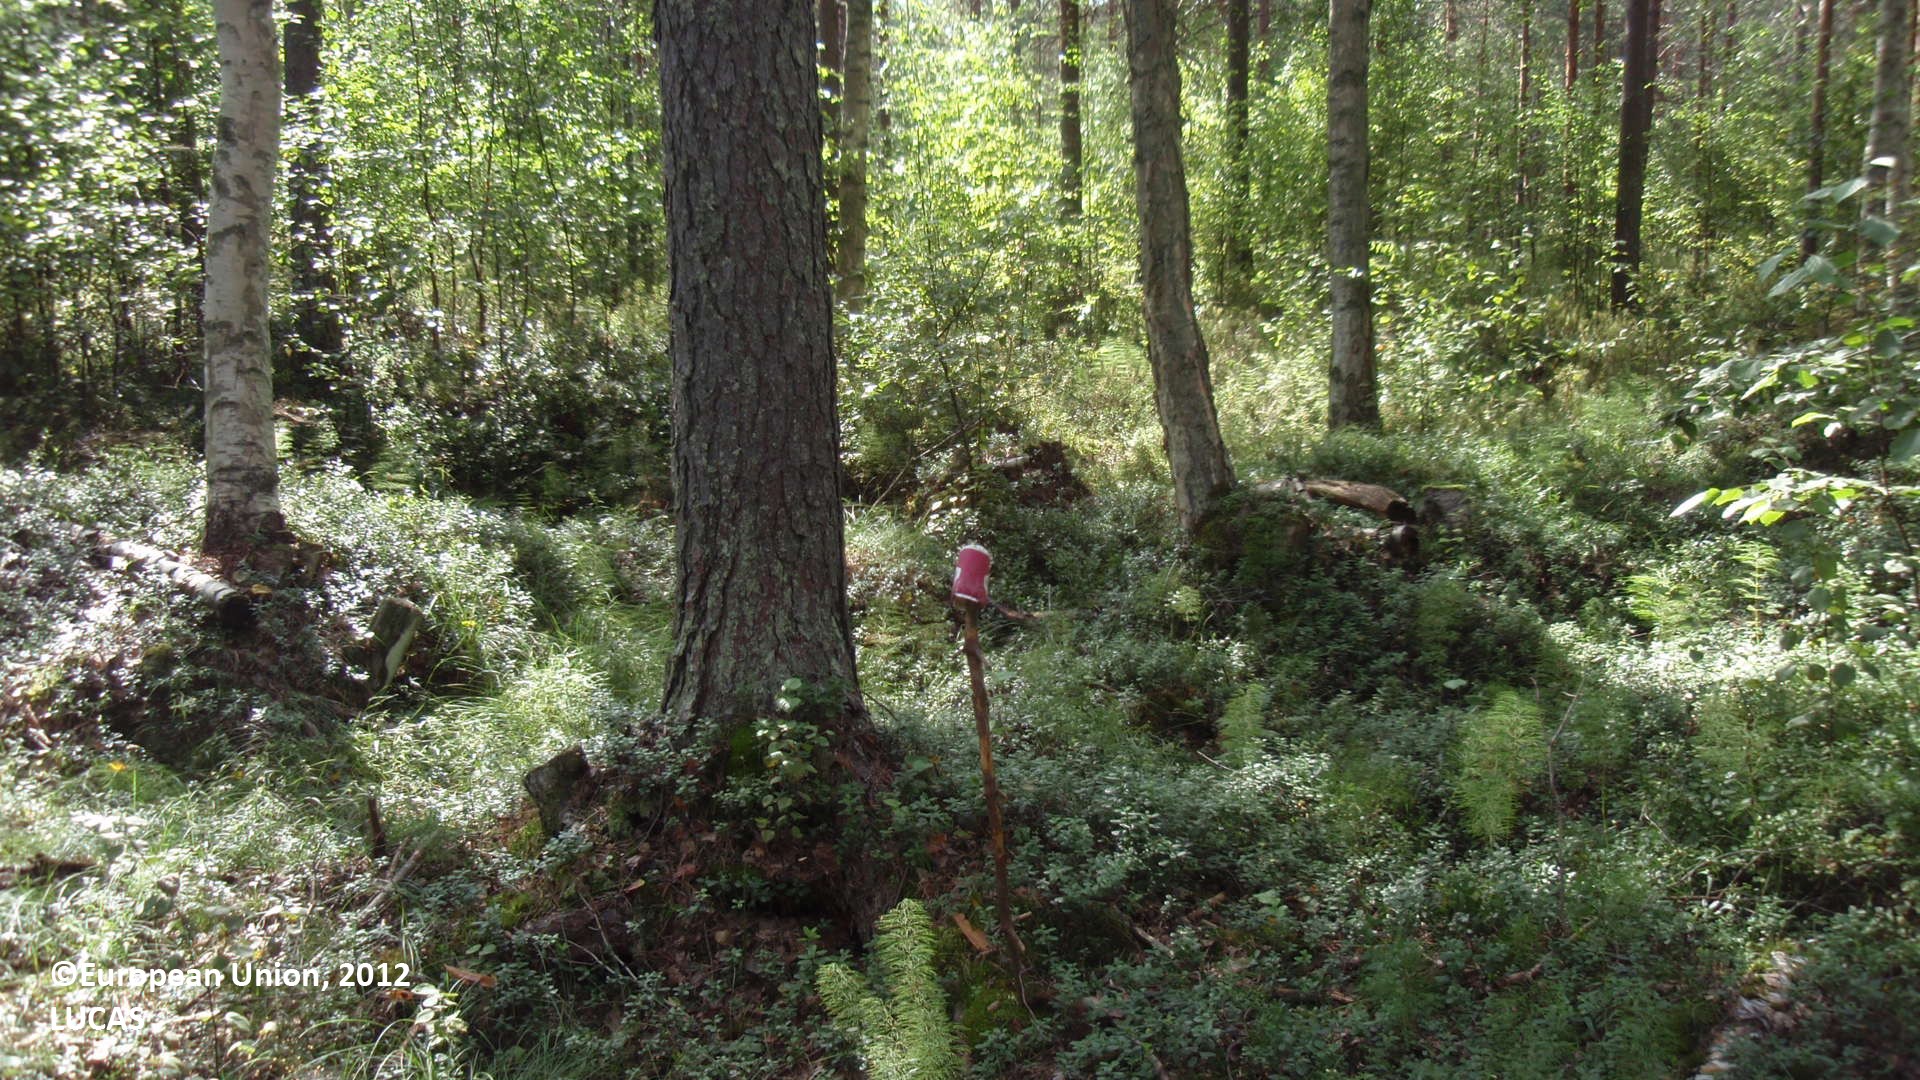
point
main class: Woodland
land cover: Pine dominated mixed woodland
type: boreal forest
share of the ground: 50 - 75 %
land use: Forestry
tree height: > 5 m
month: August
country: FI
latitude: 61.1951
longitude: 28.1565
